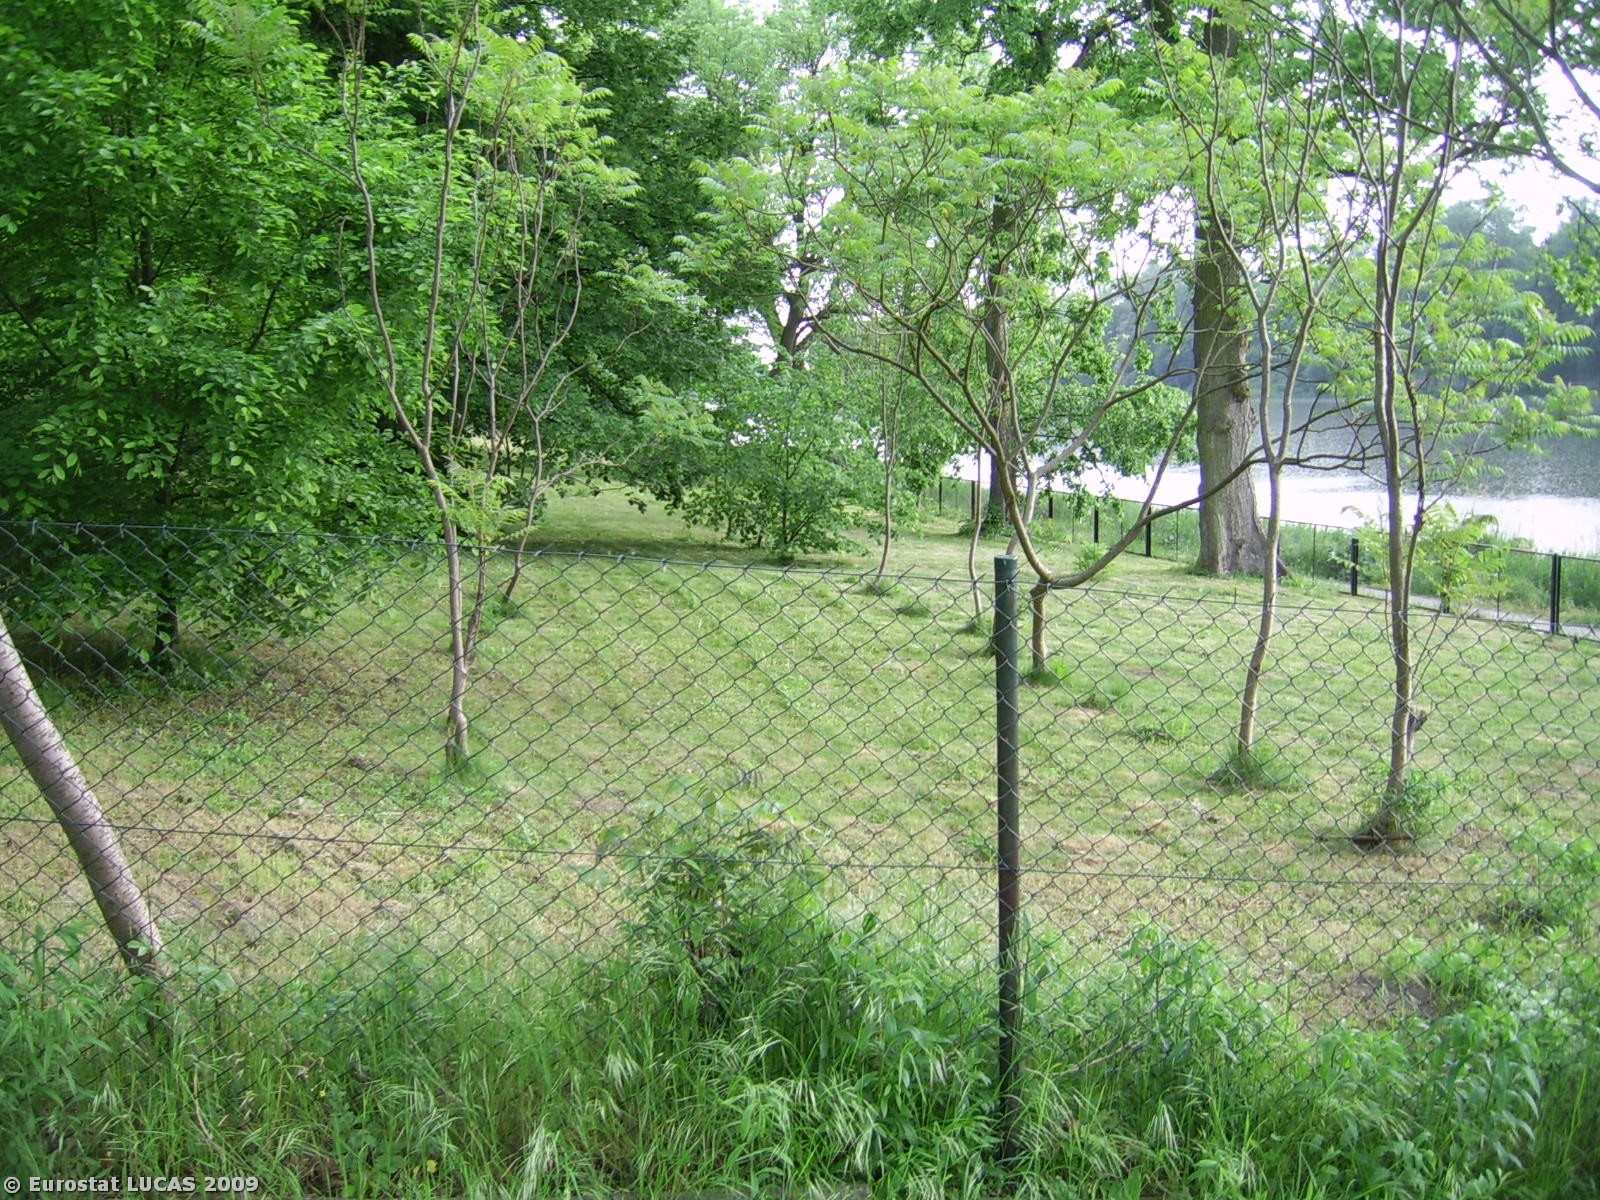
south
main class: Grassland
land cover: Grassland without tree/shrub cover
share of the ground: 50 - 75 %
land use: Residential
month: May
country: PL
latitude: 52.6524
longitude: 17.9531
